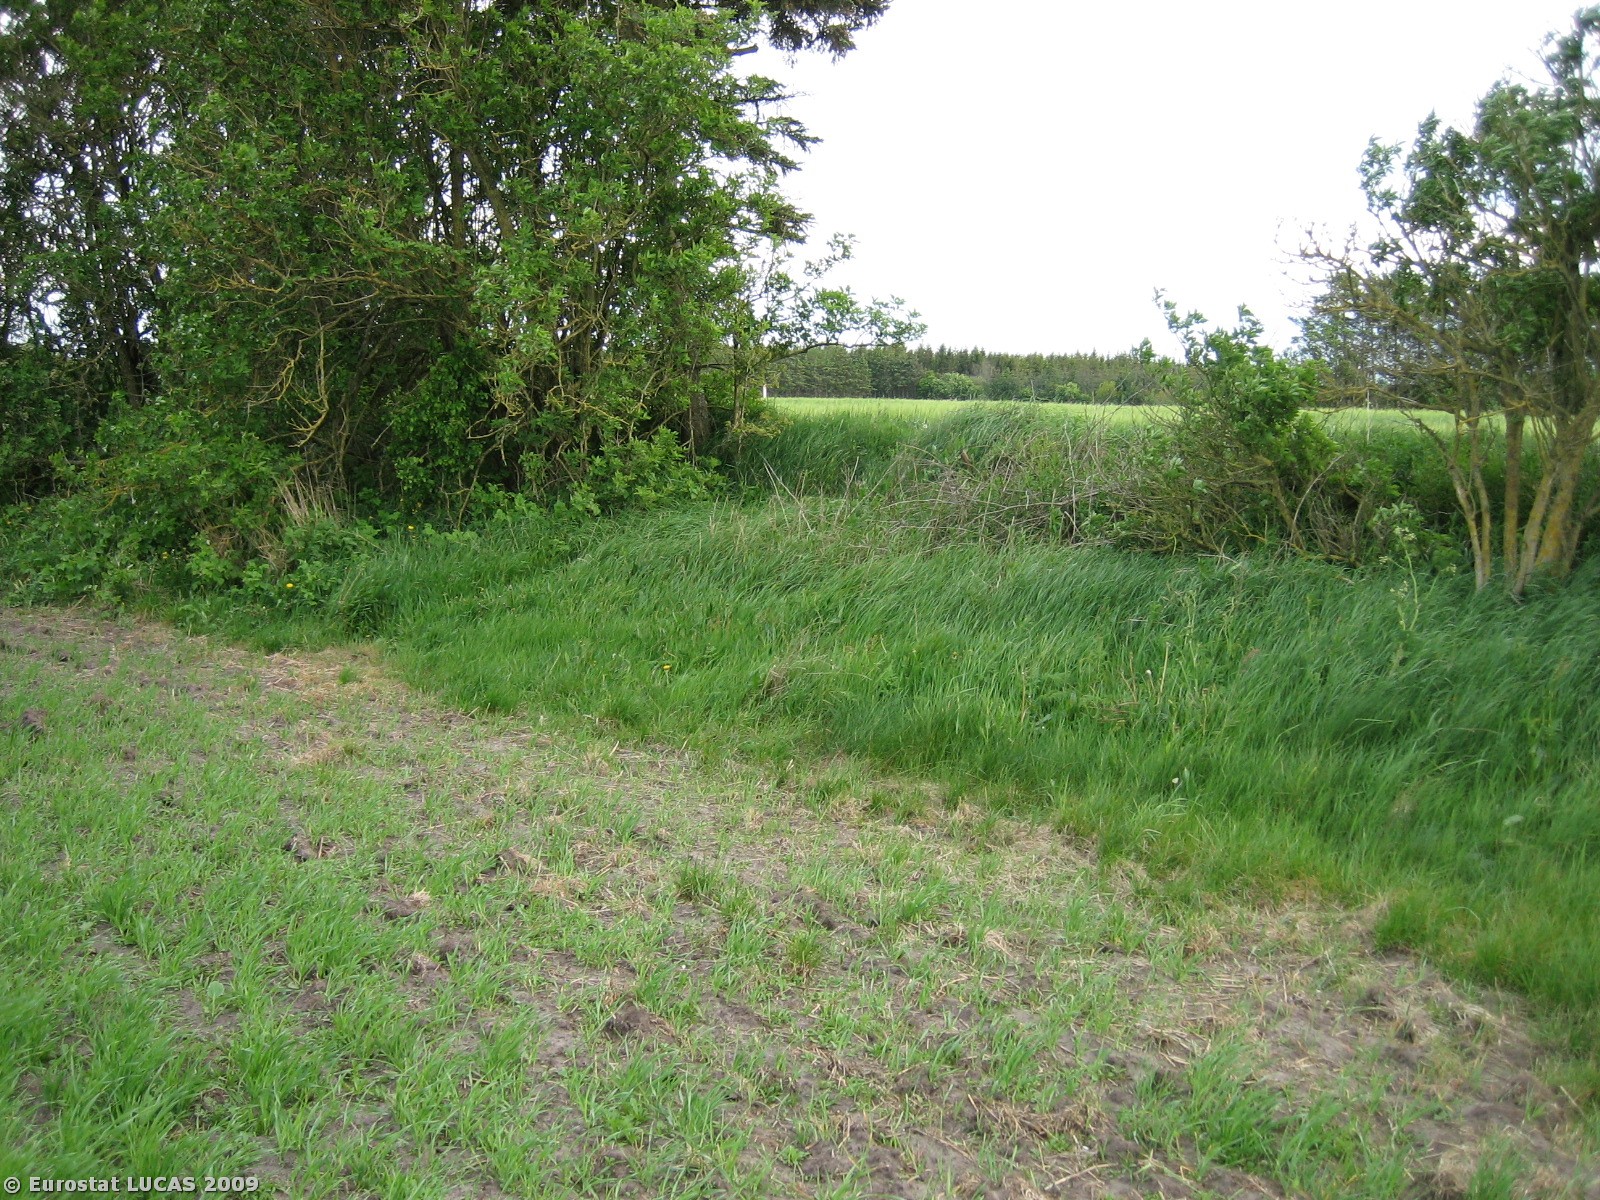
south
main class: Cropland
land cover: Barley
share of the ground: > 75 %
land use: Agriculture (excluding fallow land and kitchen gardens)
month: May
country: DK
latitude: 56.0872
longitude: 8.3465
